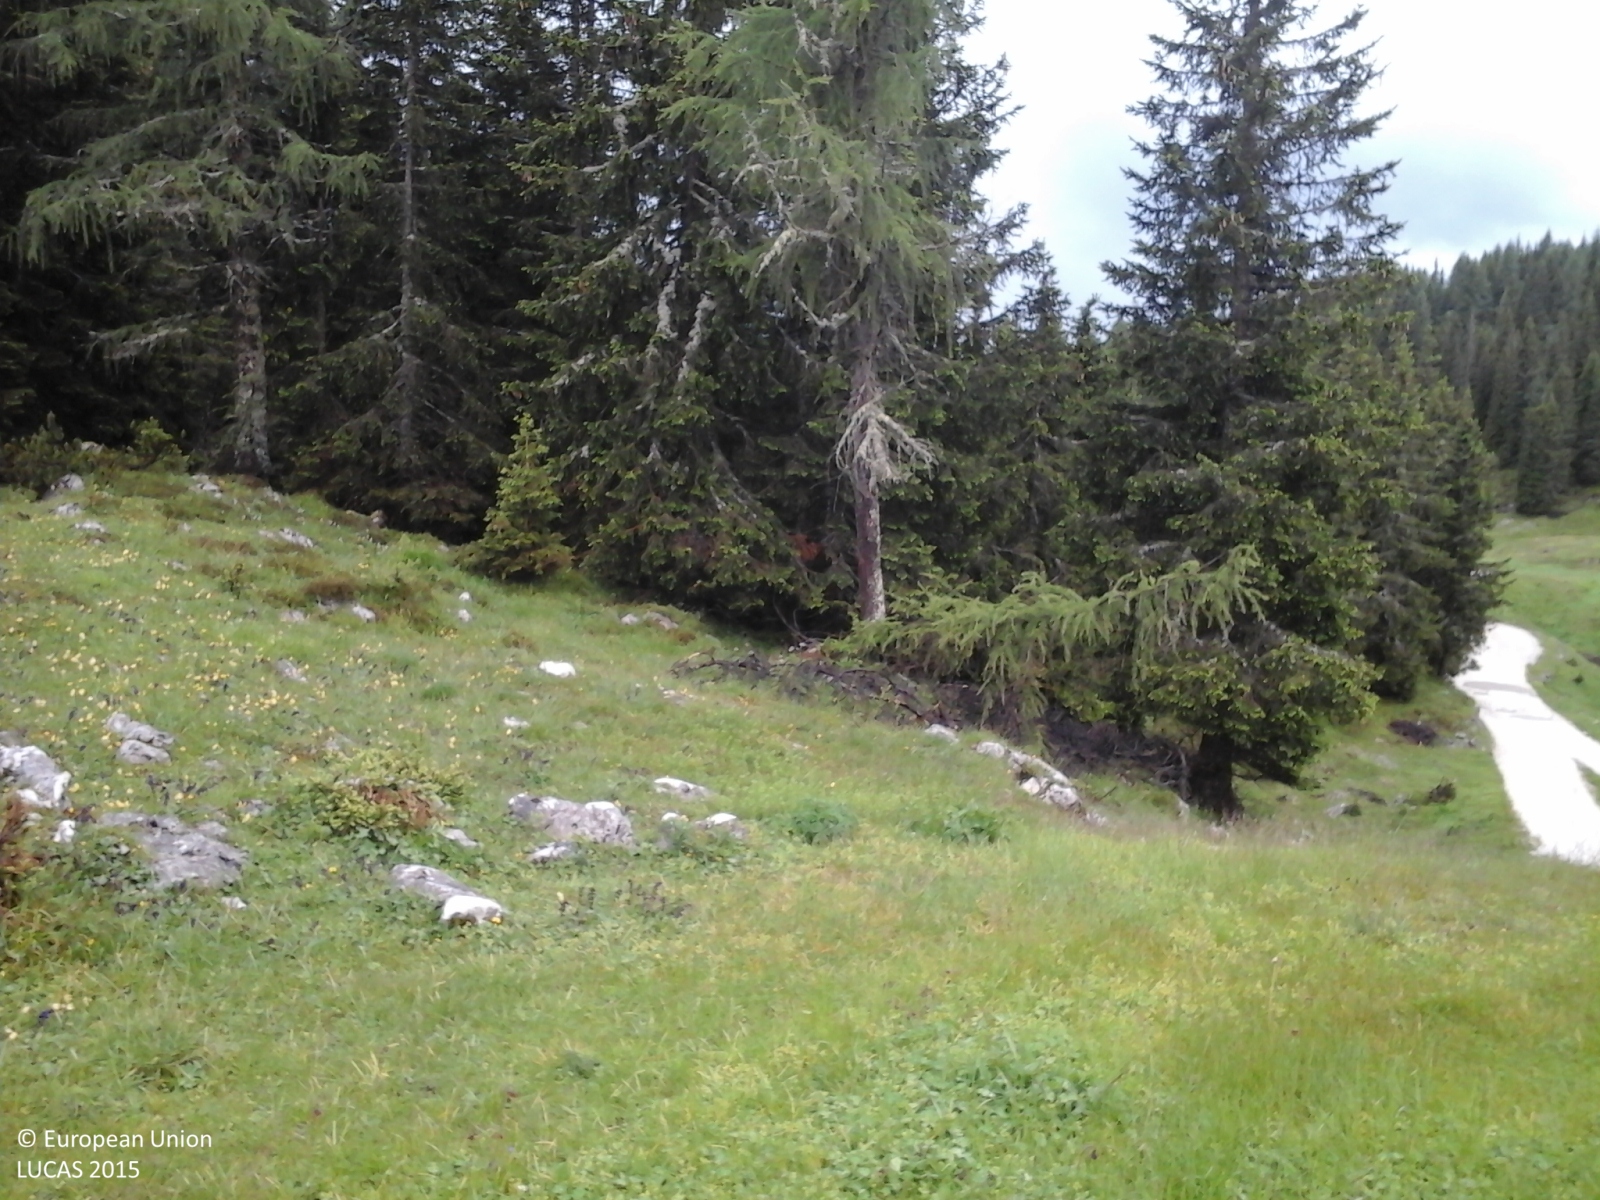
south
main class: Grassland
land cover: Grassland without tree/shrub cover
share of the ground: > 75 %
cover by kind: herbaceous plants 100 %
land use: Agriculture (excluding fallow land and kitchen gardens)
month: June
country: IT
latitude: 45.9799
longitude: 11.5338
